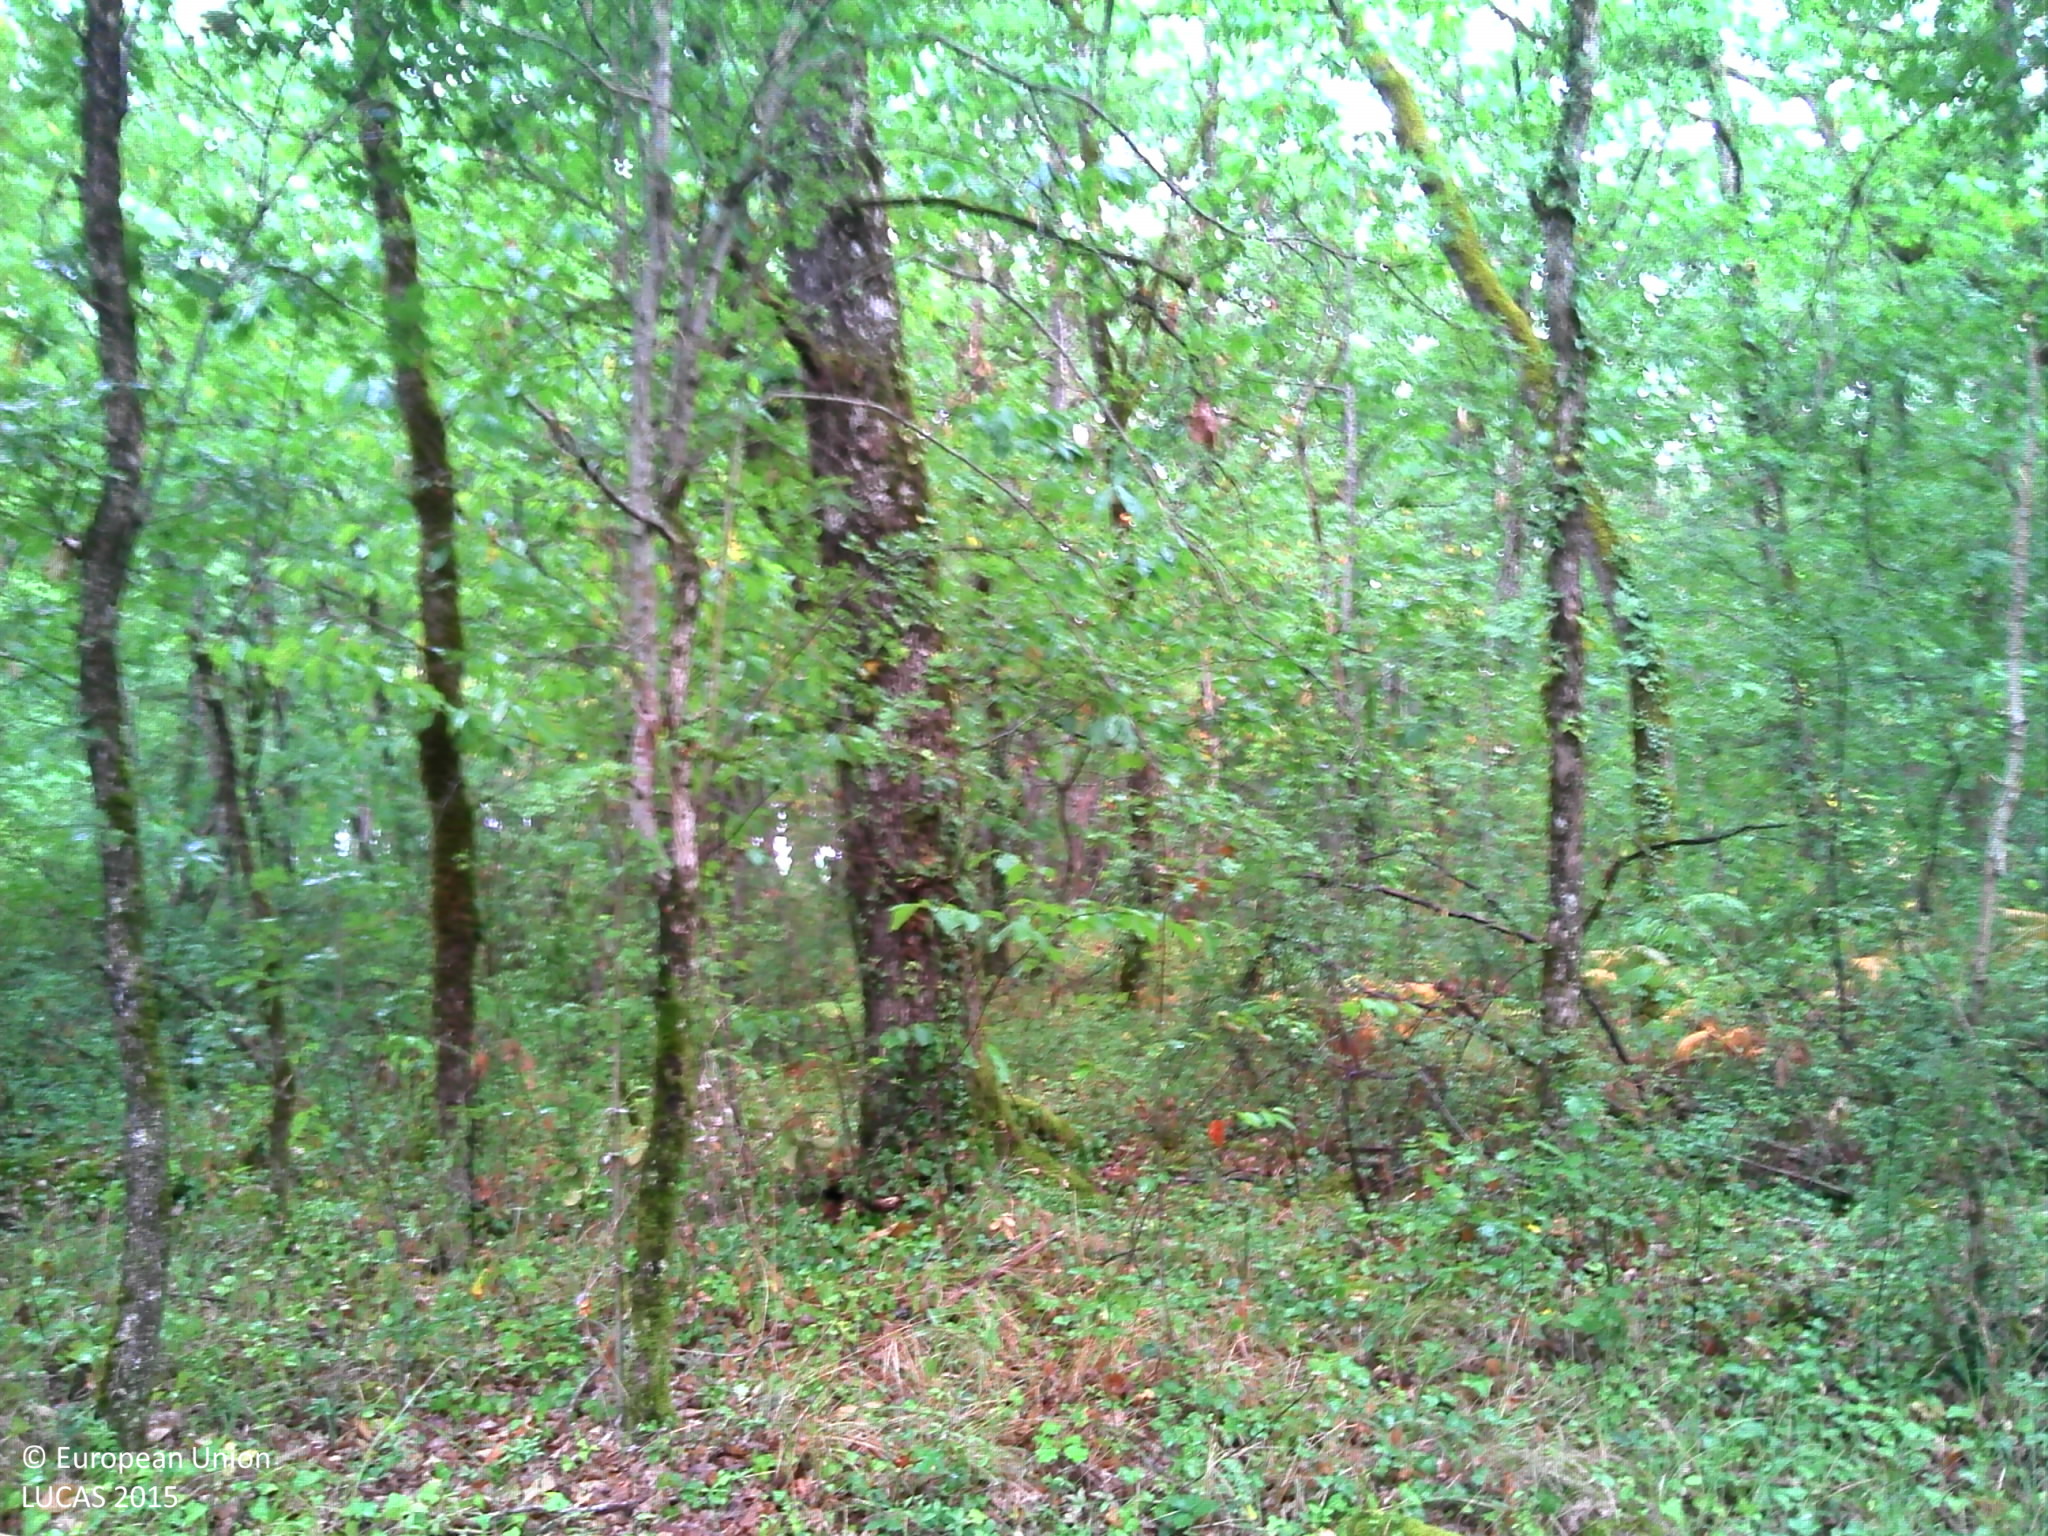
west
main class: Woodland
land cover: Broadleaved woodland
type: thermophilous deciduous forest
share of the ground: > 75 %
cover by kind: broadleaved forest trees 80 %, herbaceous plants 10 %, shrubs 5 %, lichens and mosses 5 %
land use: Forestry
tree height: > 5 m
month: August
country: FR
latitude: 44.6353
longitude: 0.8544
